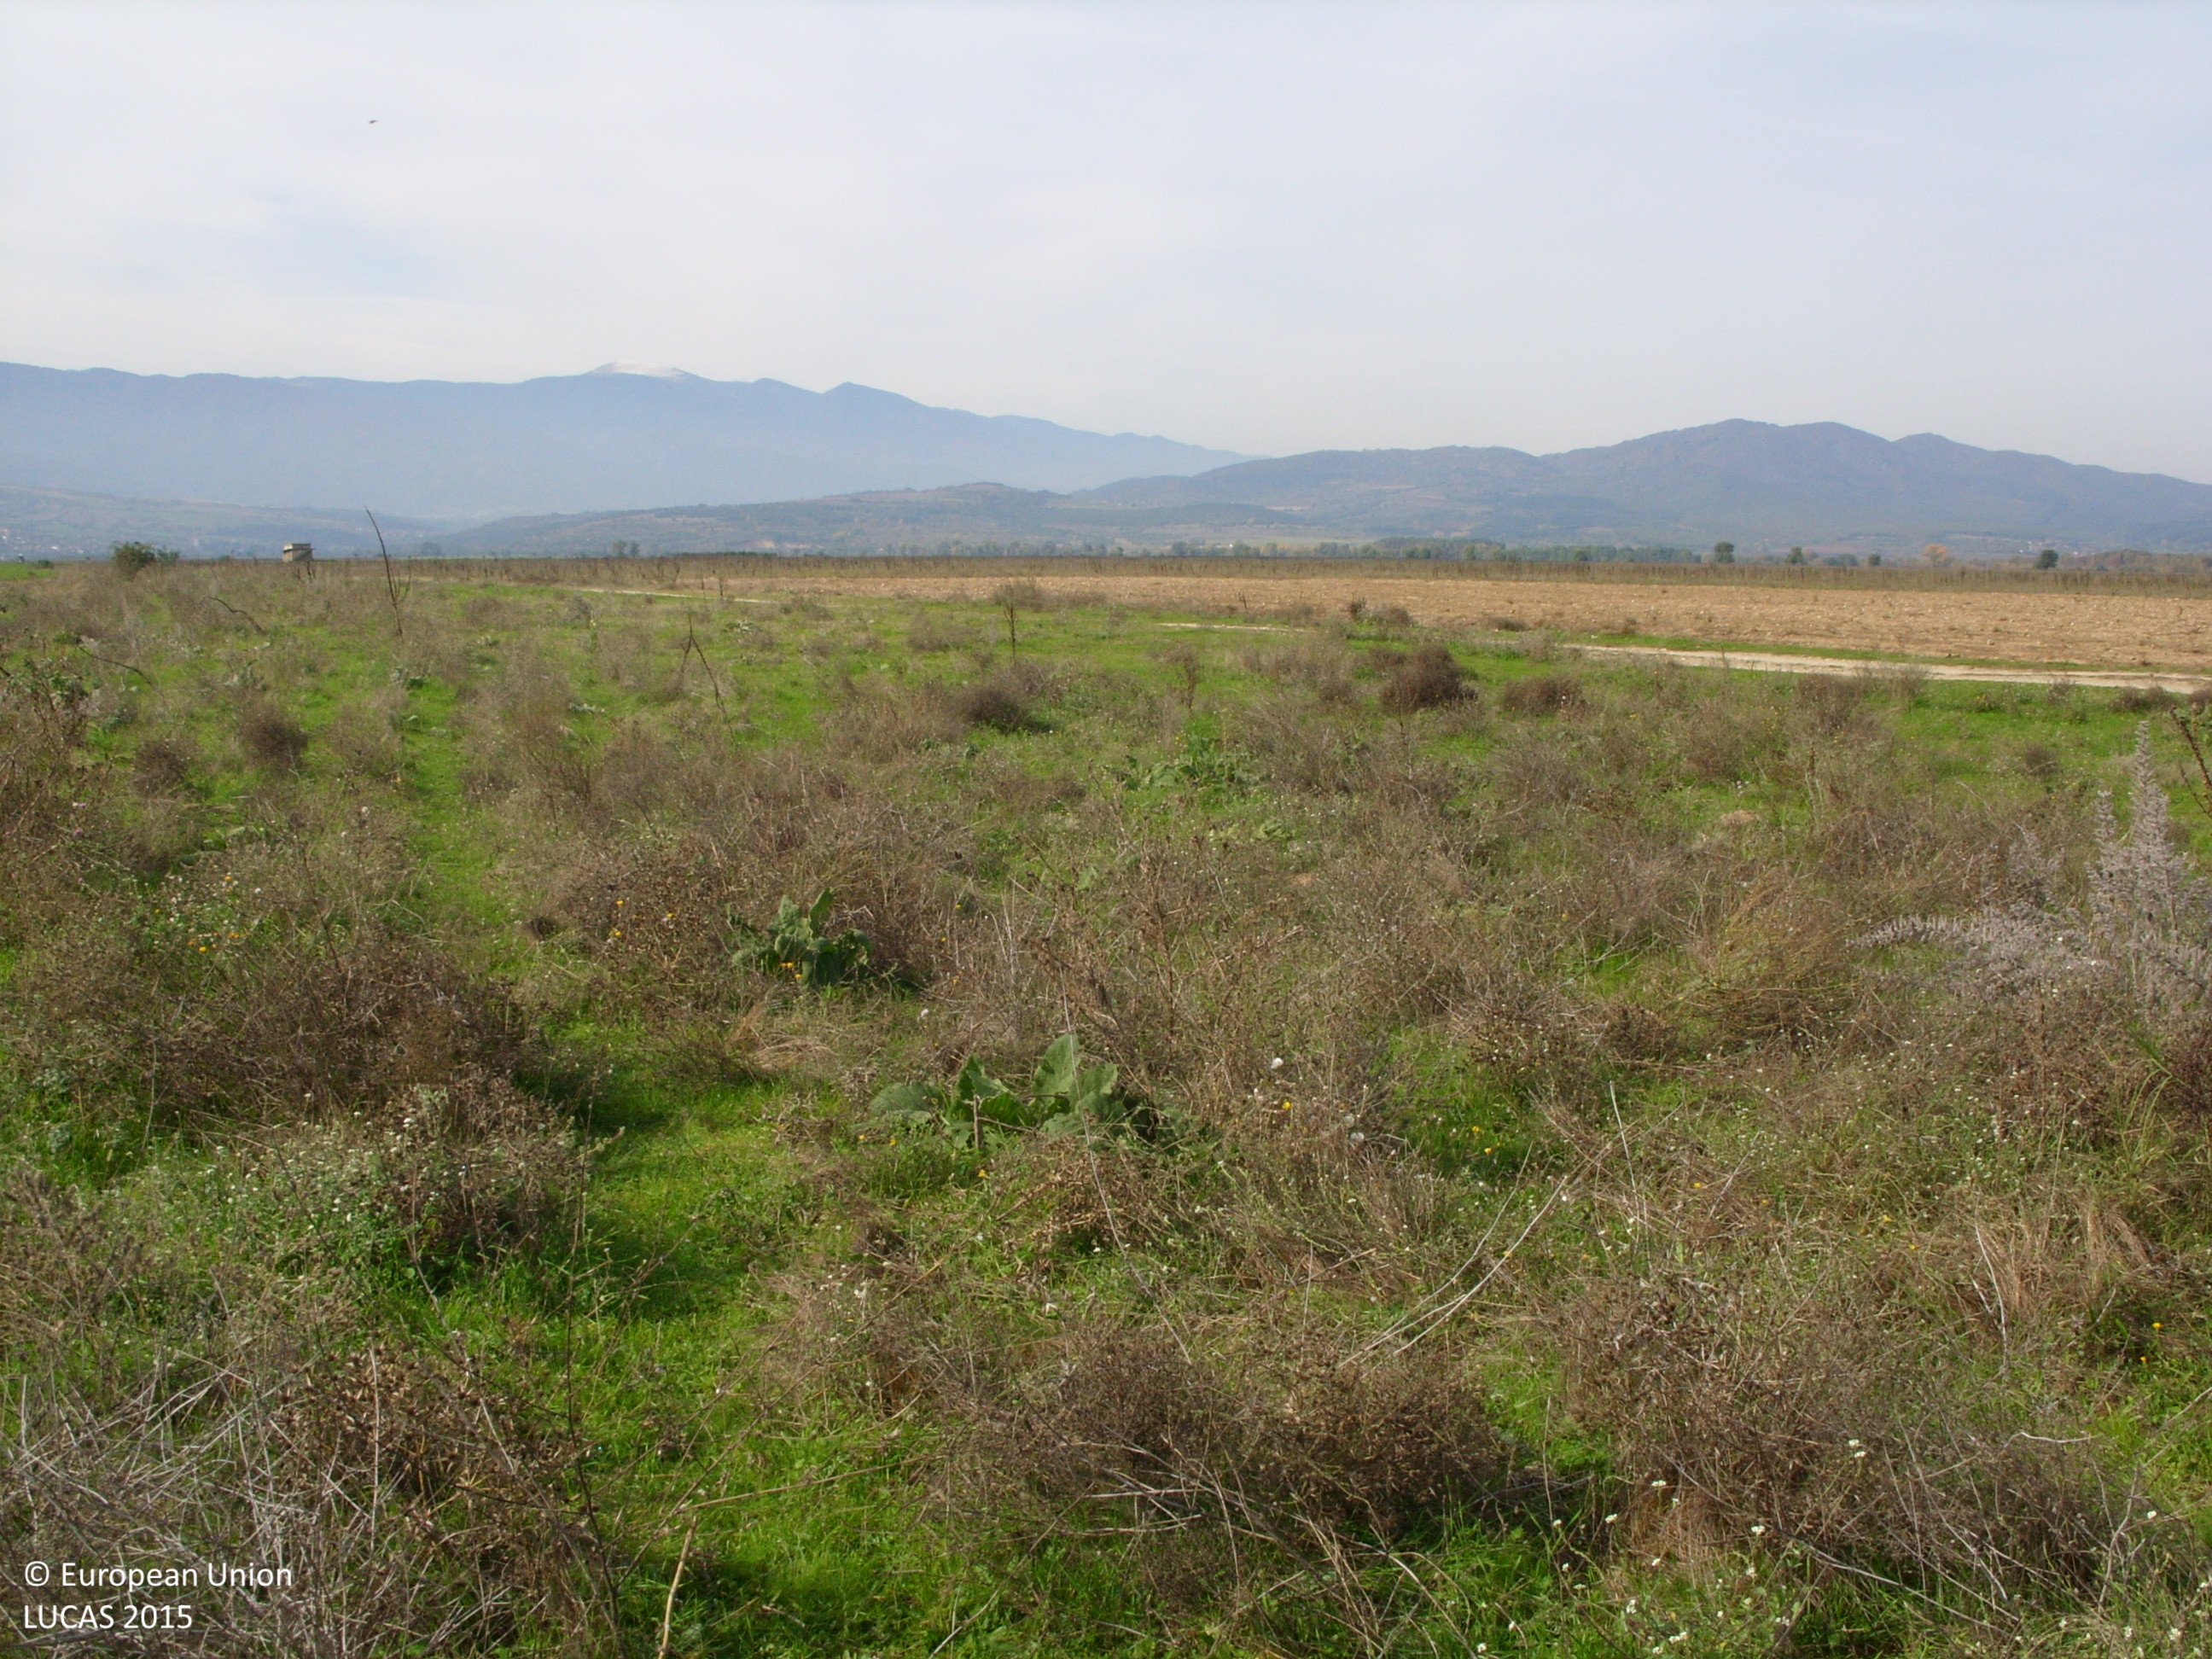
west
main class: Grassland
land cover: Grassland with sparse tree/shrub cover
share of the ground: > 75 %
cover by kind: herbaceous plants 85 %, shrubs 10 %, broadleaved forest trees 5 %
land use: Fallow land
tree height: < 5 m
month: October
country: BG
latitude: 42.2284
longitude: 24.1084
